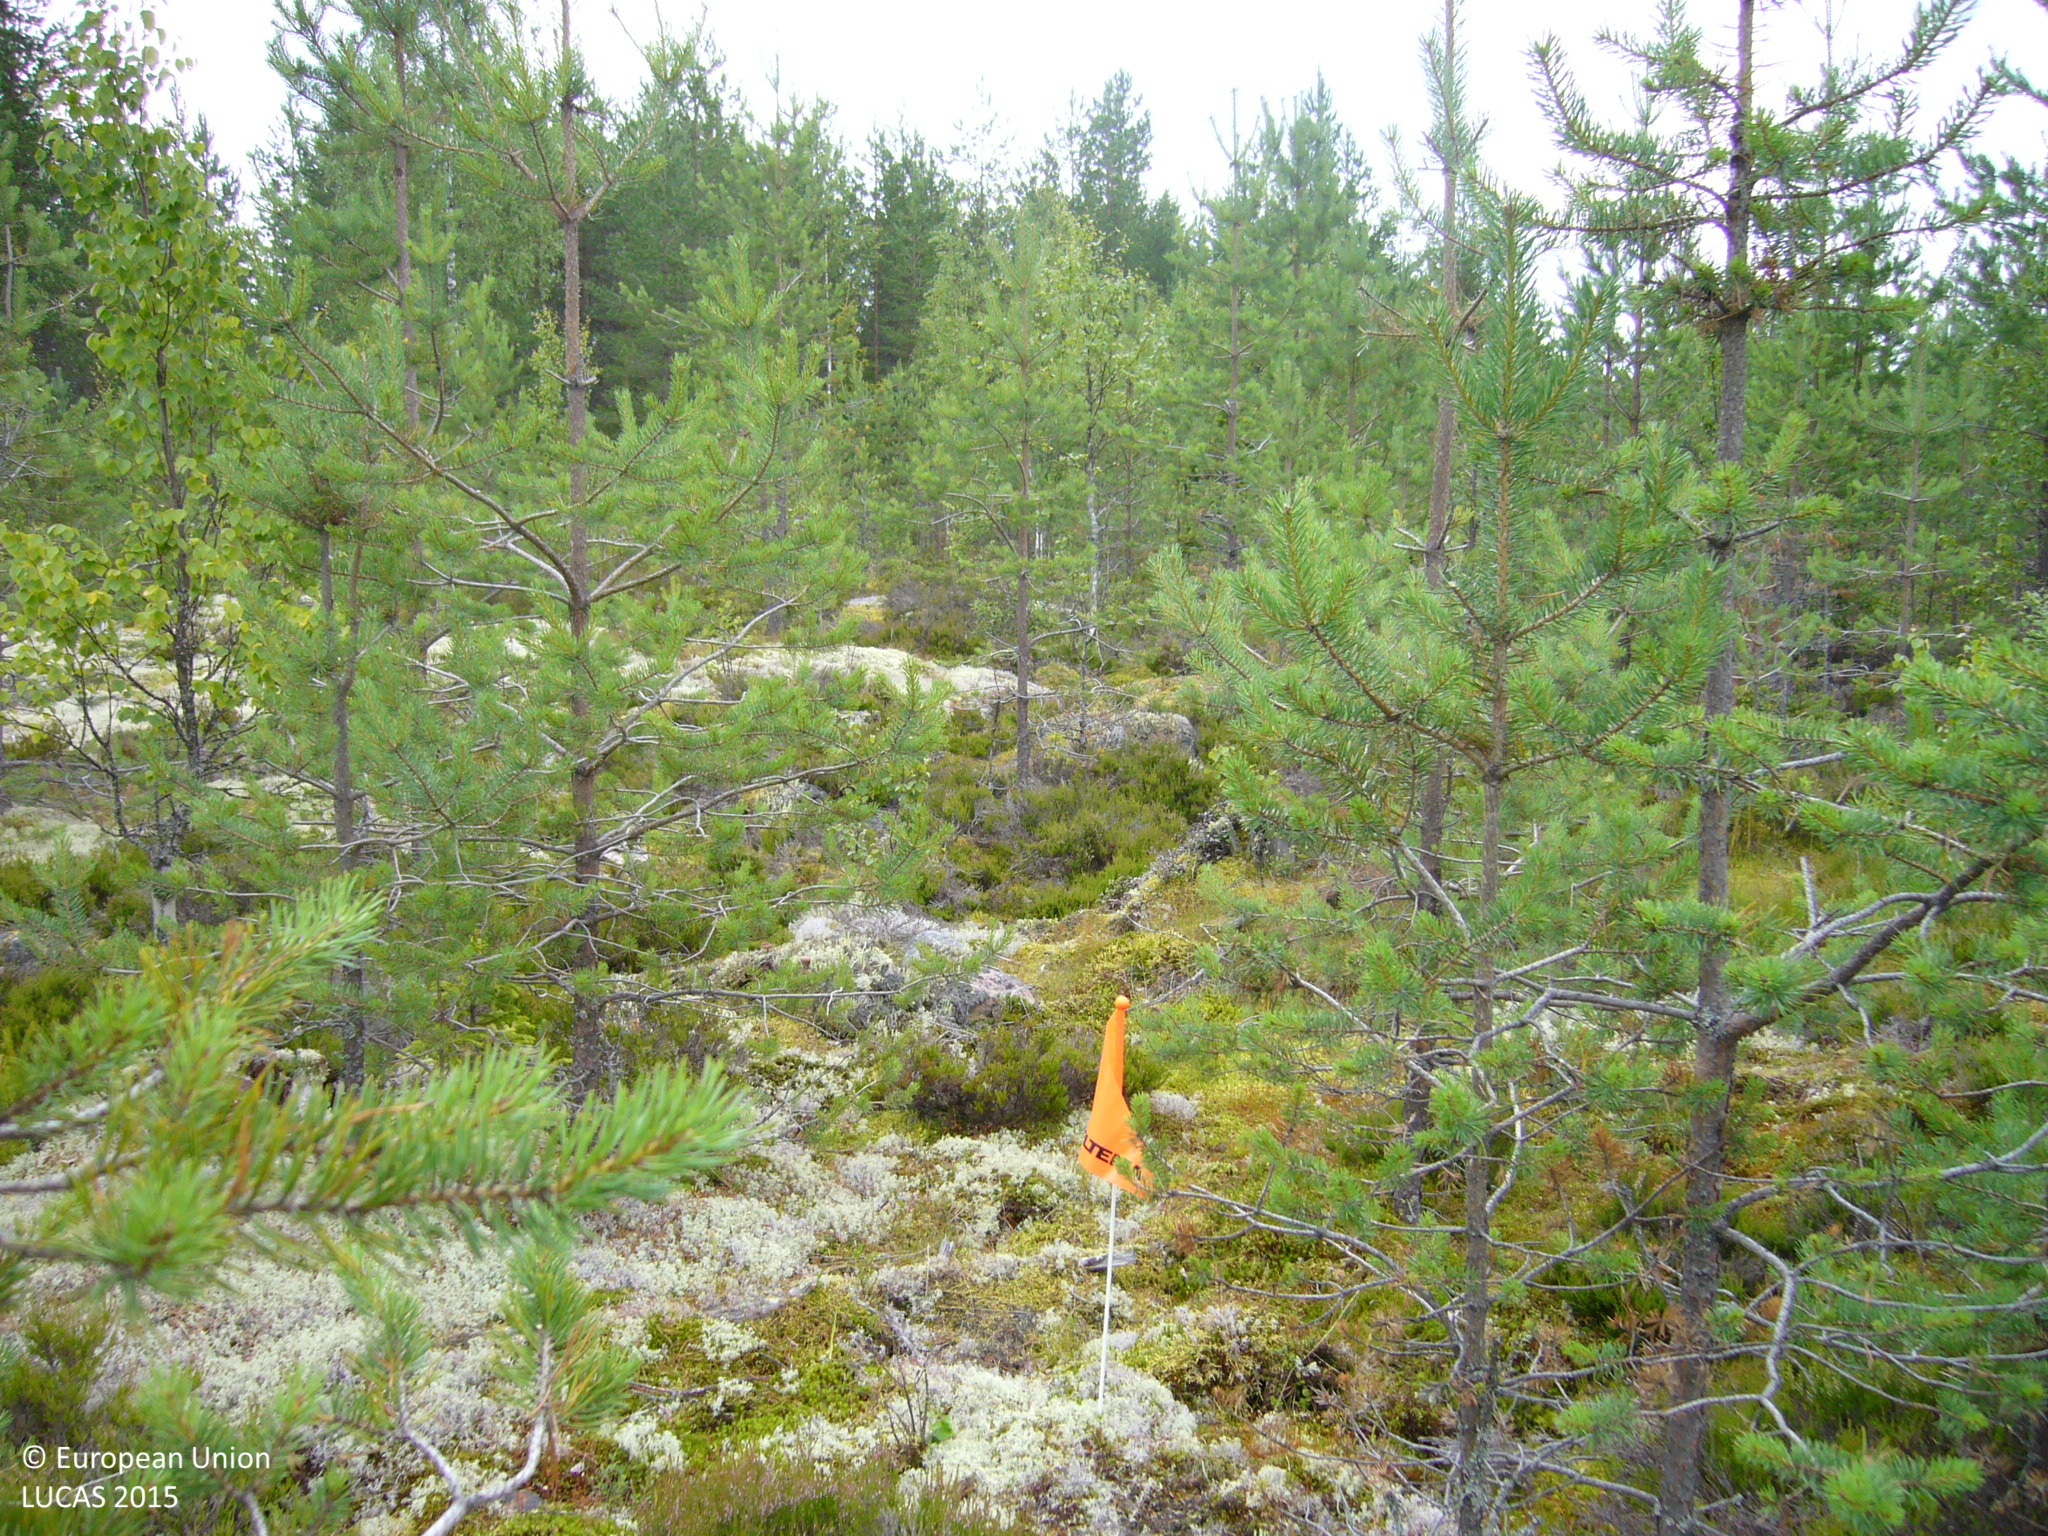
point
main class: Woodland
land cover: Pine dominated mixed woodland
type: boreal forest
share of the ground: 50 - 75 %
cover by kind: coniferous forest trees 30 %, lichens and mosses 30 %, broadleaved forest trees 20 %, consolidated bare surface 20 %
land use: Forestry
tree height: < 5 m
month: July
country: FI
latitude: 63.9447
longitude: 26.2139
